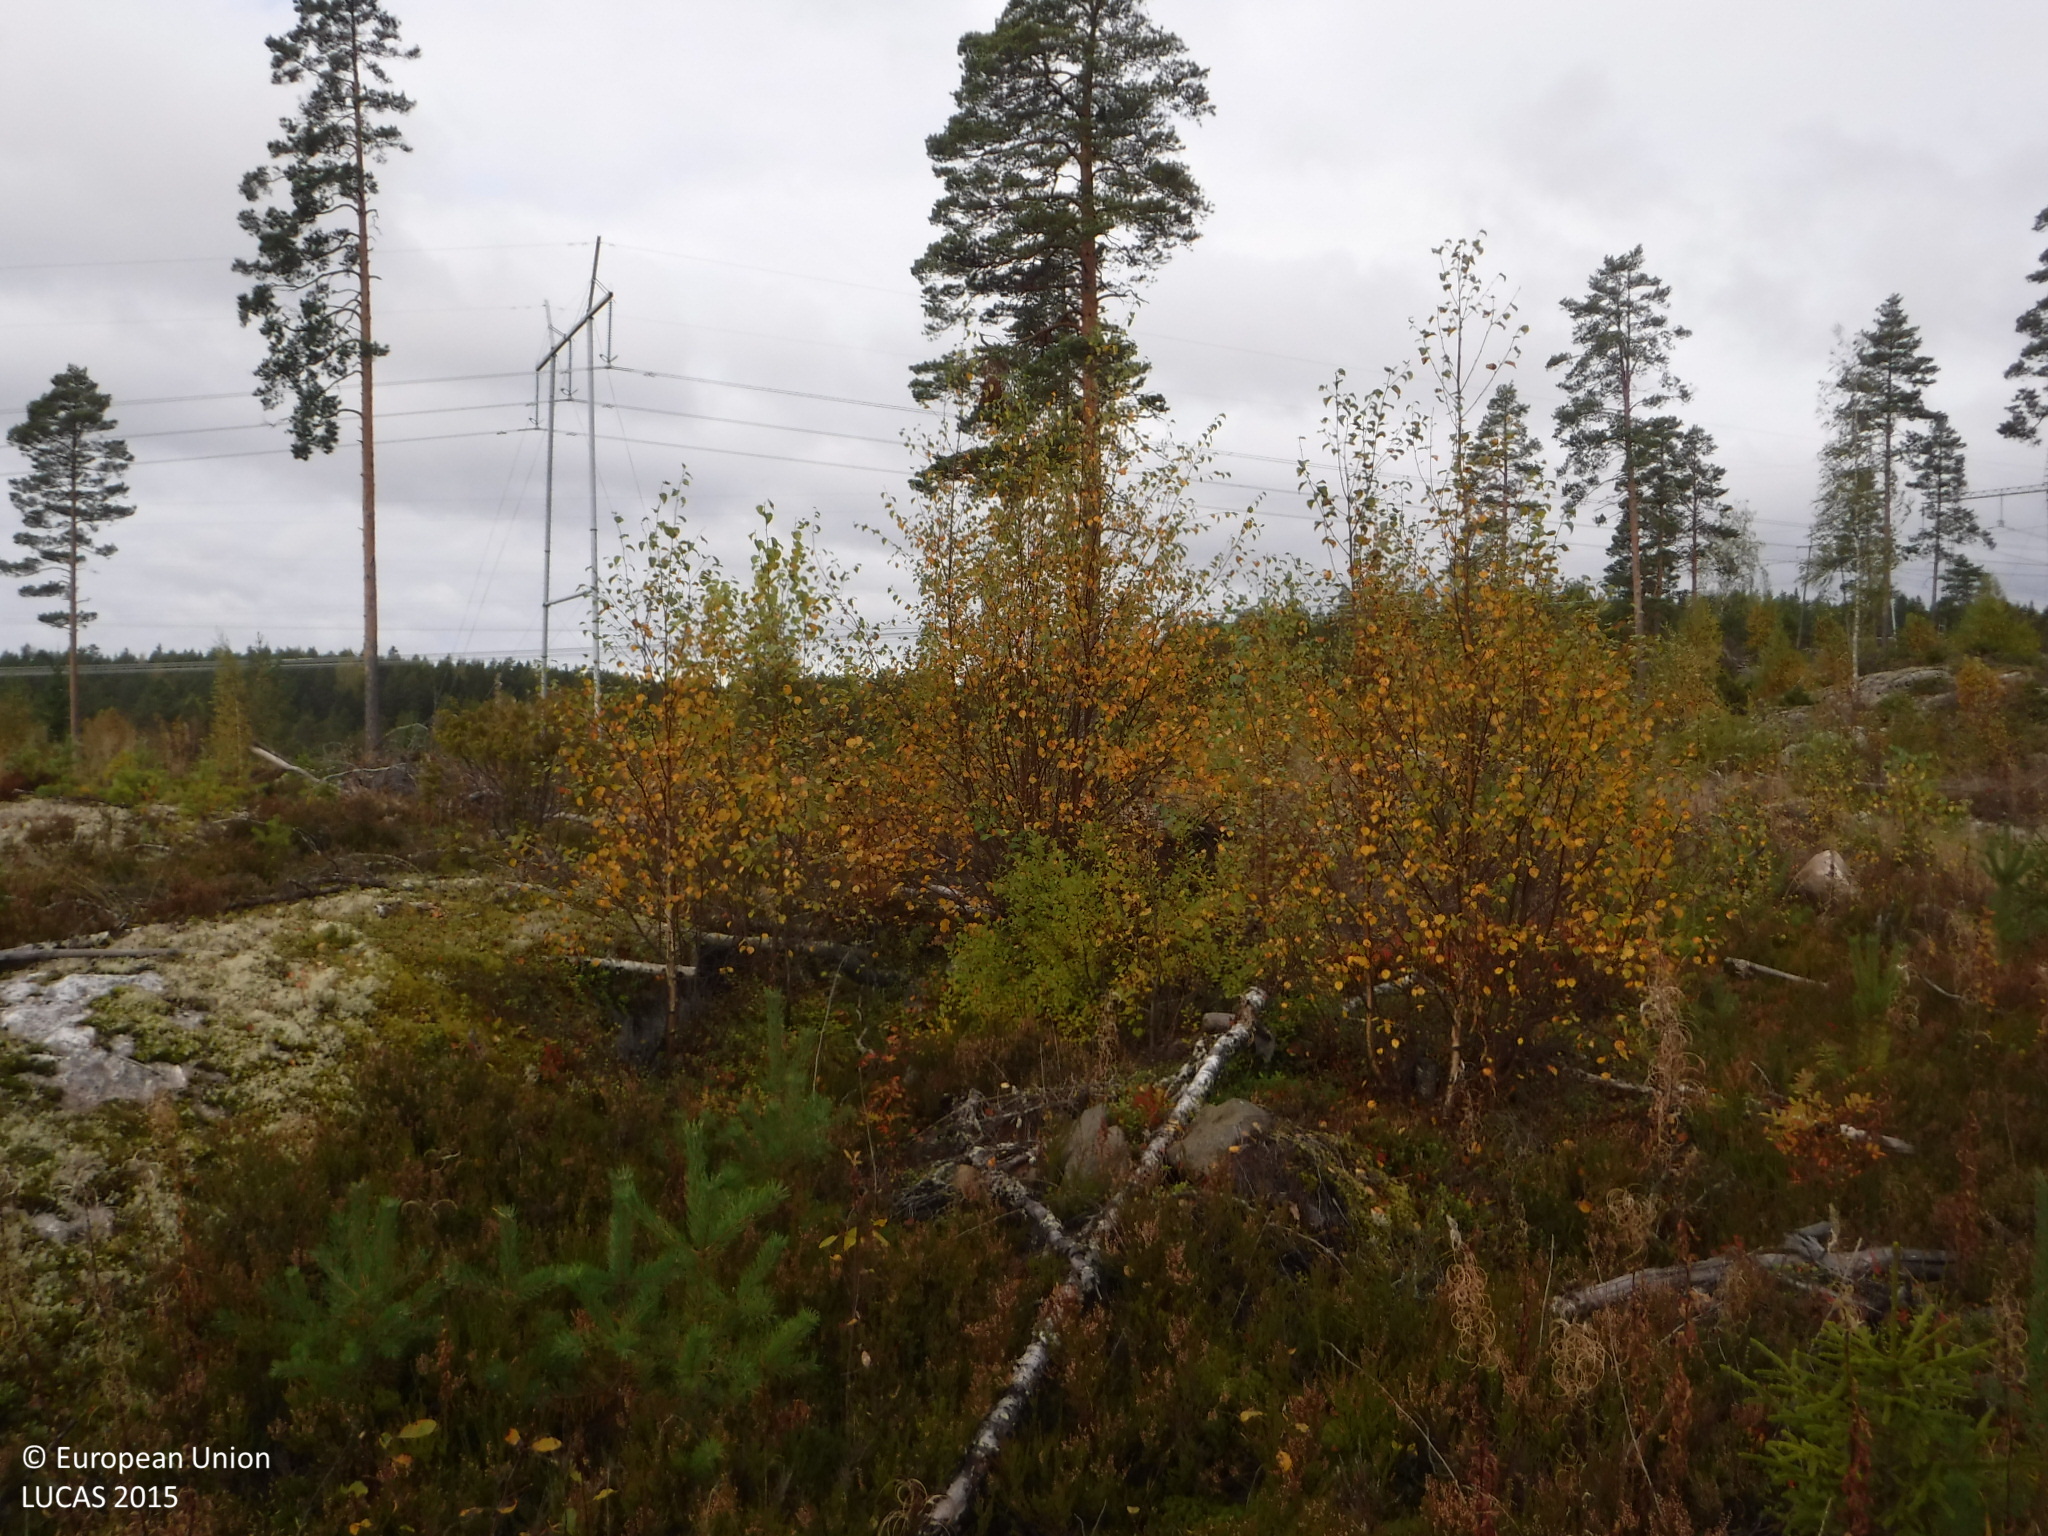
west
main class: Woodland
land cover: Other mixed woodland
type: boreal forest
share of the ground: 10 - 25 %
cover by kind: shrubs 60 %, lichens and mosses 20 %, herbaceous plants 10 %, coniferous forest trees 5 %, broadleaved forest trees 5 %
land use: Forestry
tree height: < 5 m
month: September
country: FI
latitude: 61.5153
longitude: 23.9782
